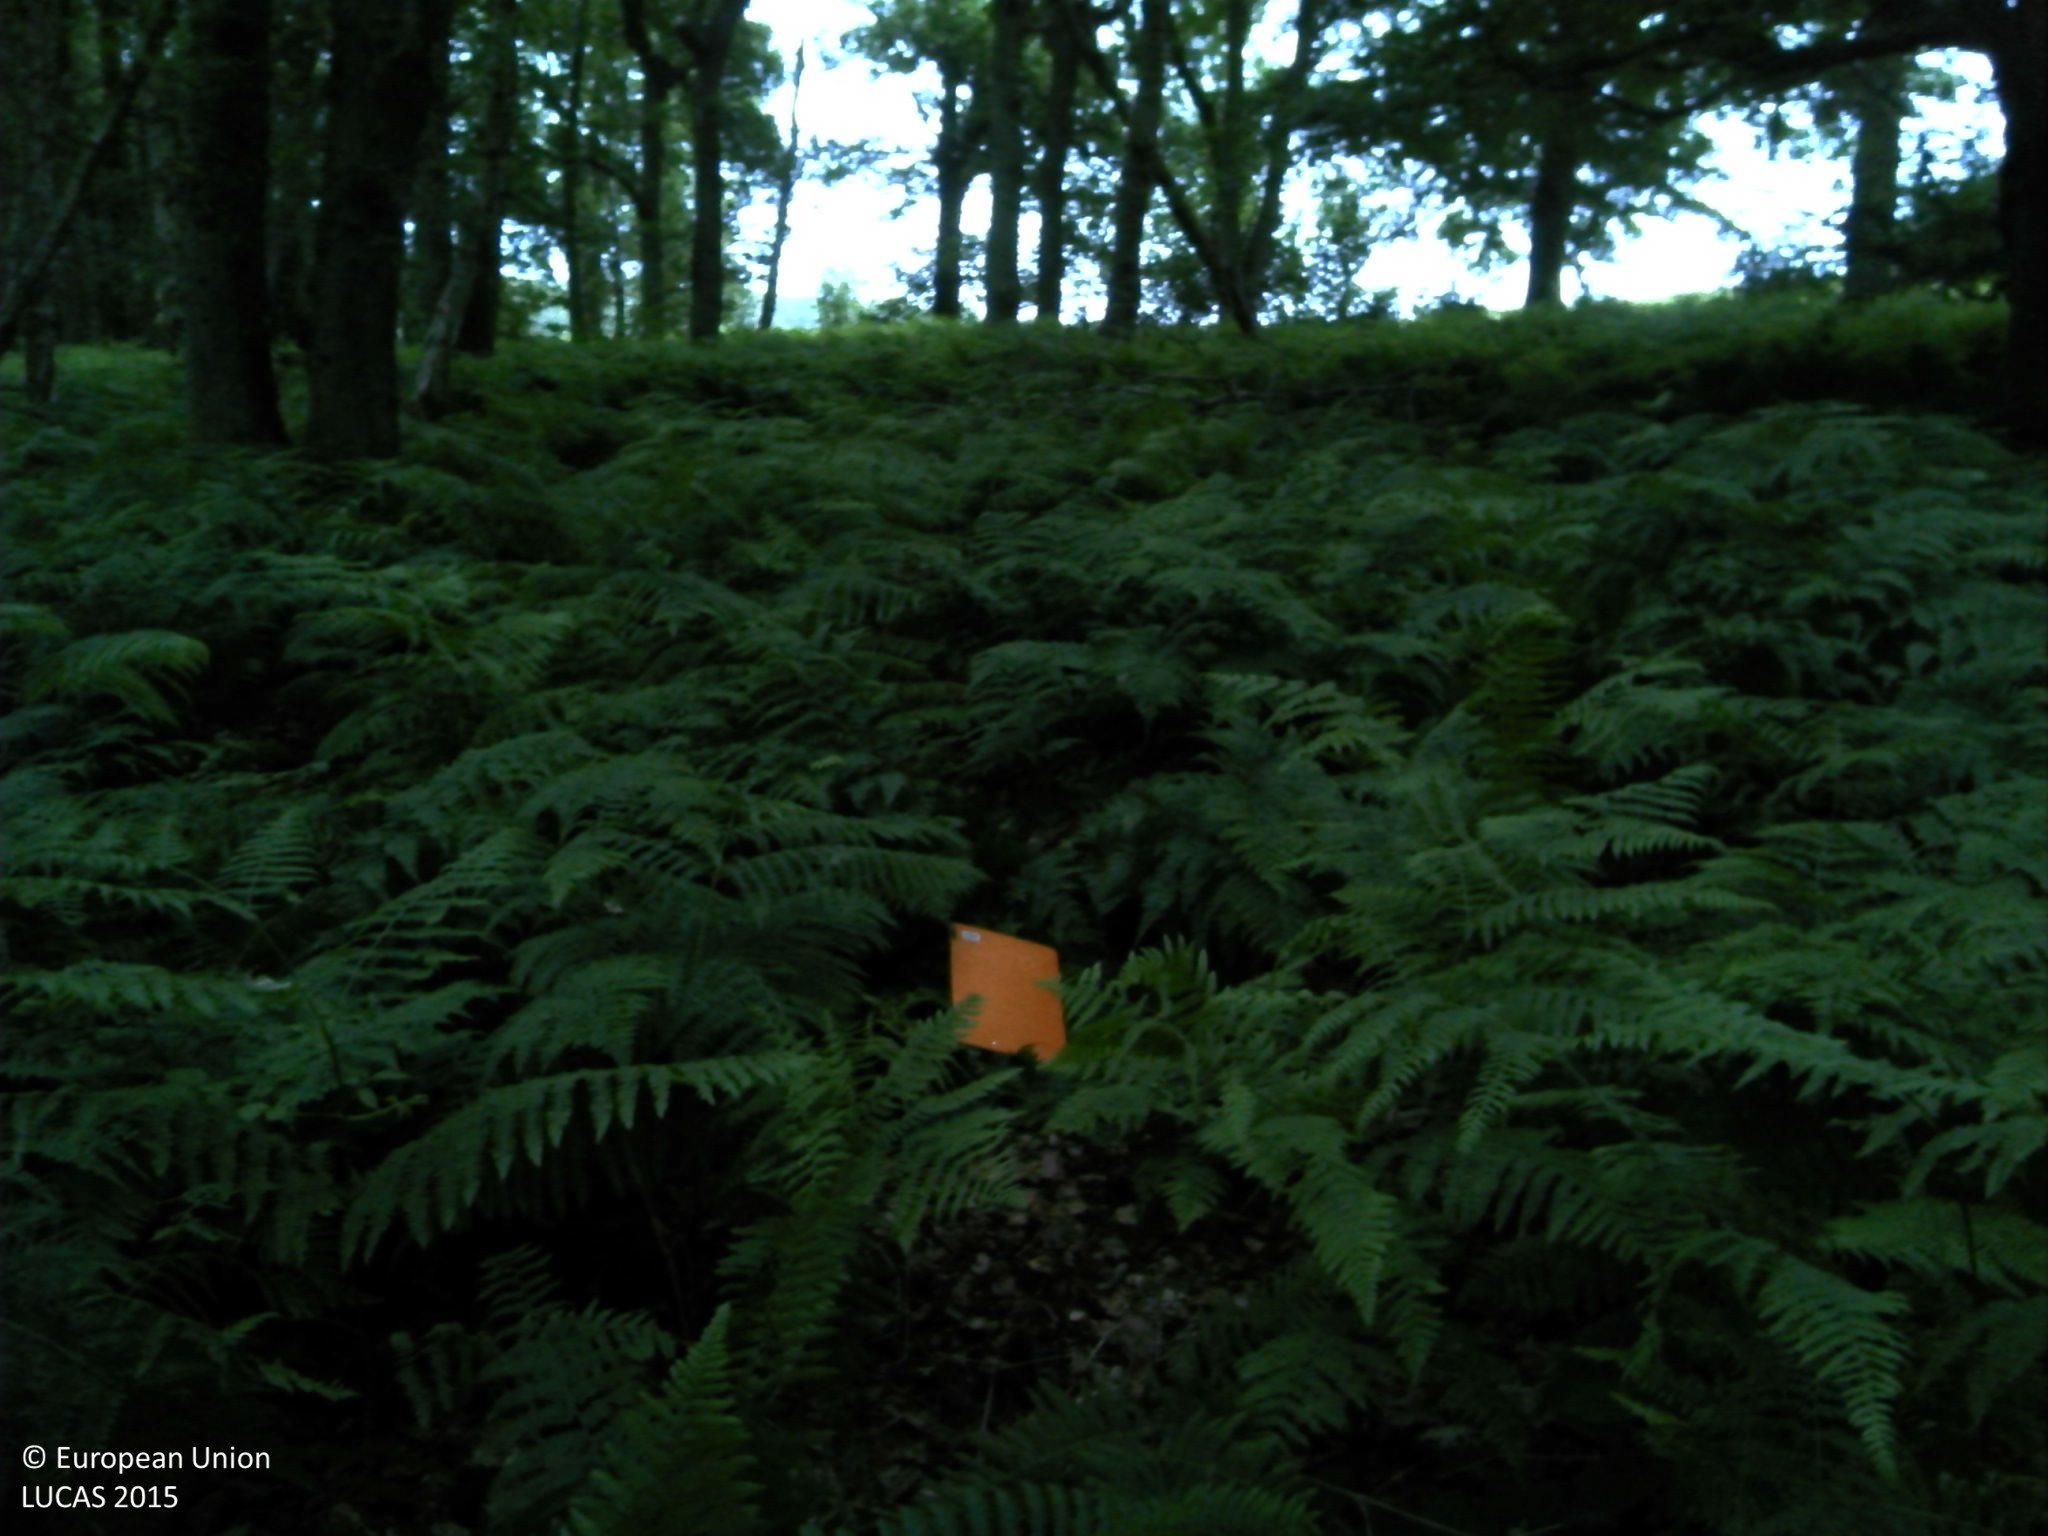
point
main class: Woodland
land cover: Broadleaved woodland
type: acidophilous oak and oak-birch forest
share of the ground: > 75 %
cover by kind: broadleaved forest trees 95 %, herbaceous plants 5 %
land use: Forestry
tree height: > 5 m
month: June
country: FR
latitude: 49.6778
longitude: 0.2840
